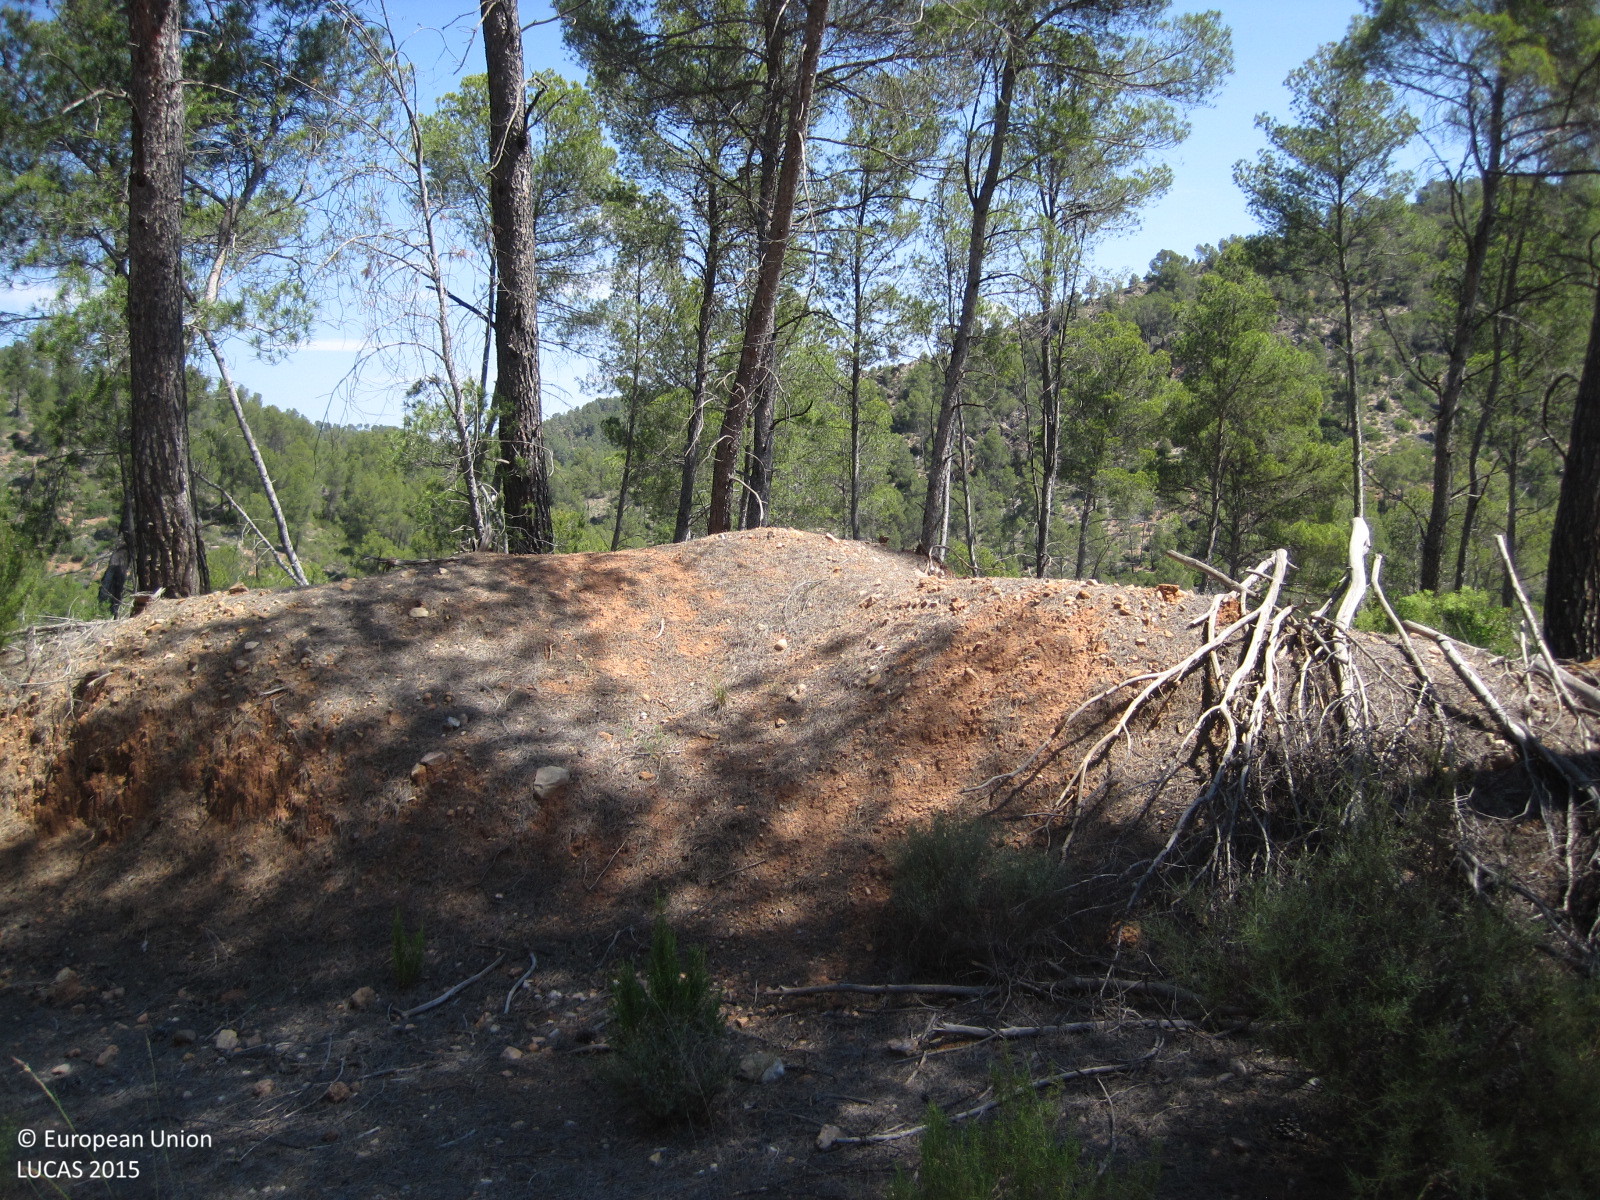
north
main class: Woodland
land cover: Pine dominated coniferous woodland
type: coniferous forest of the mediterranean region
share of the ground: 50 - 75 %
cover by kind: coniferous forest trees 70 %, shrubs 30 %
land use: Forestry
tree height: > 5 m
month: June
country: ES
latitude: 39.7599
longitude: -1.1284
